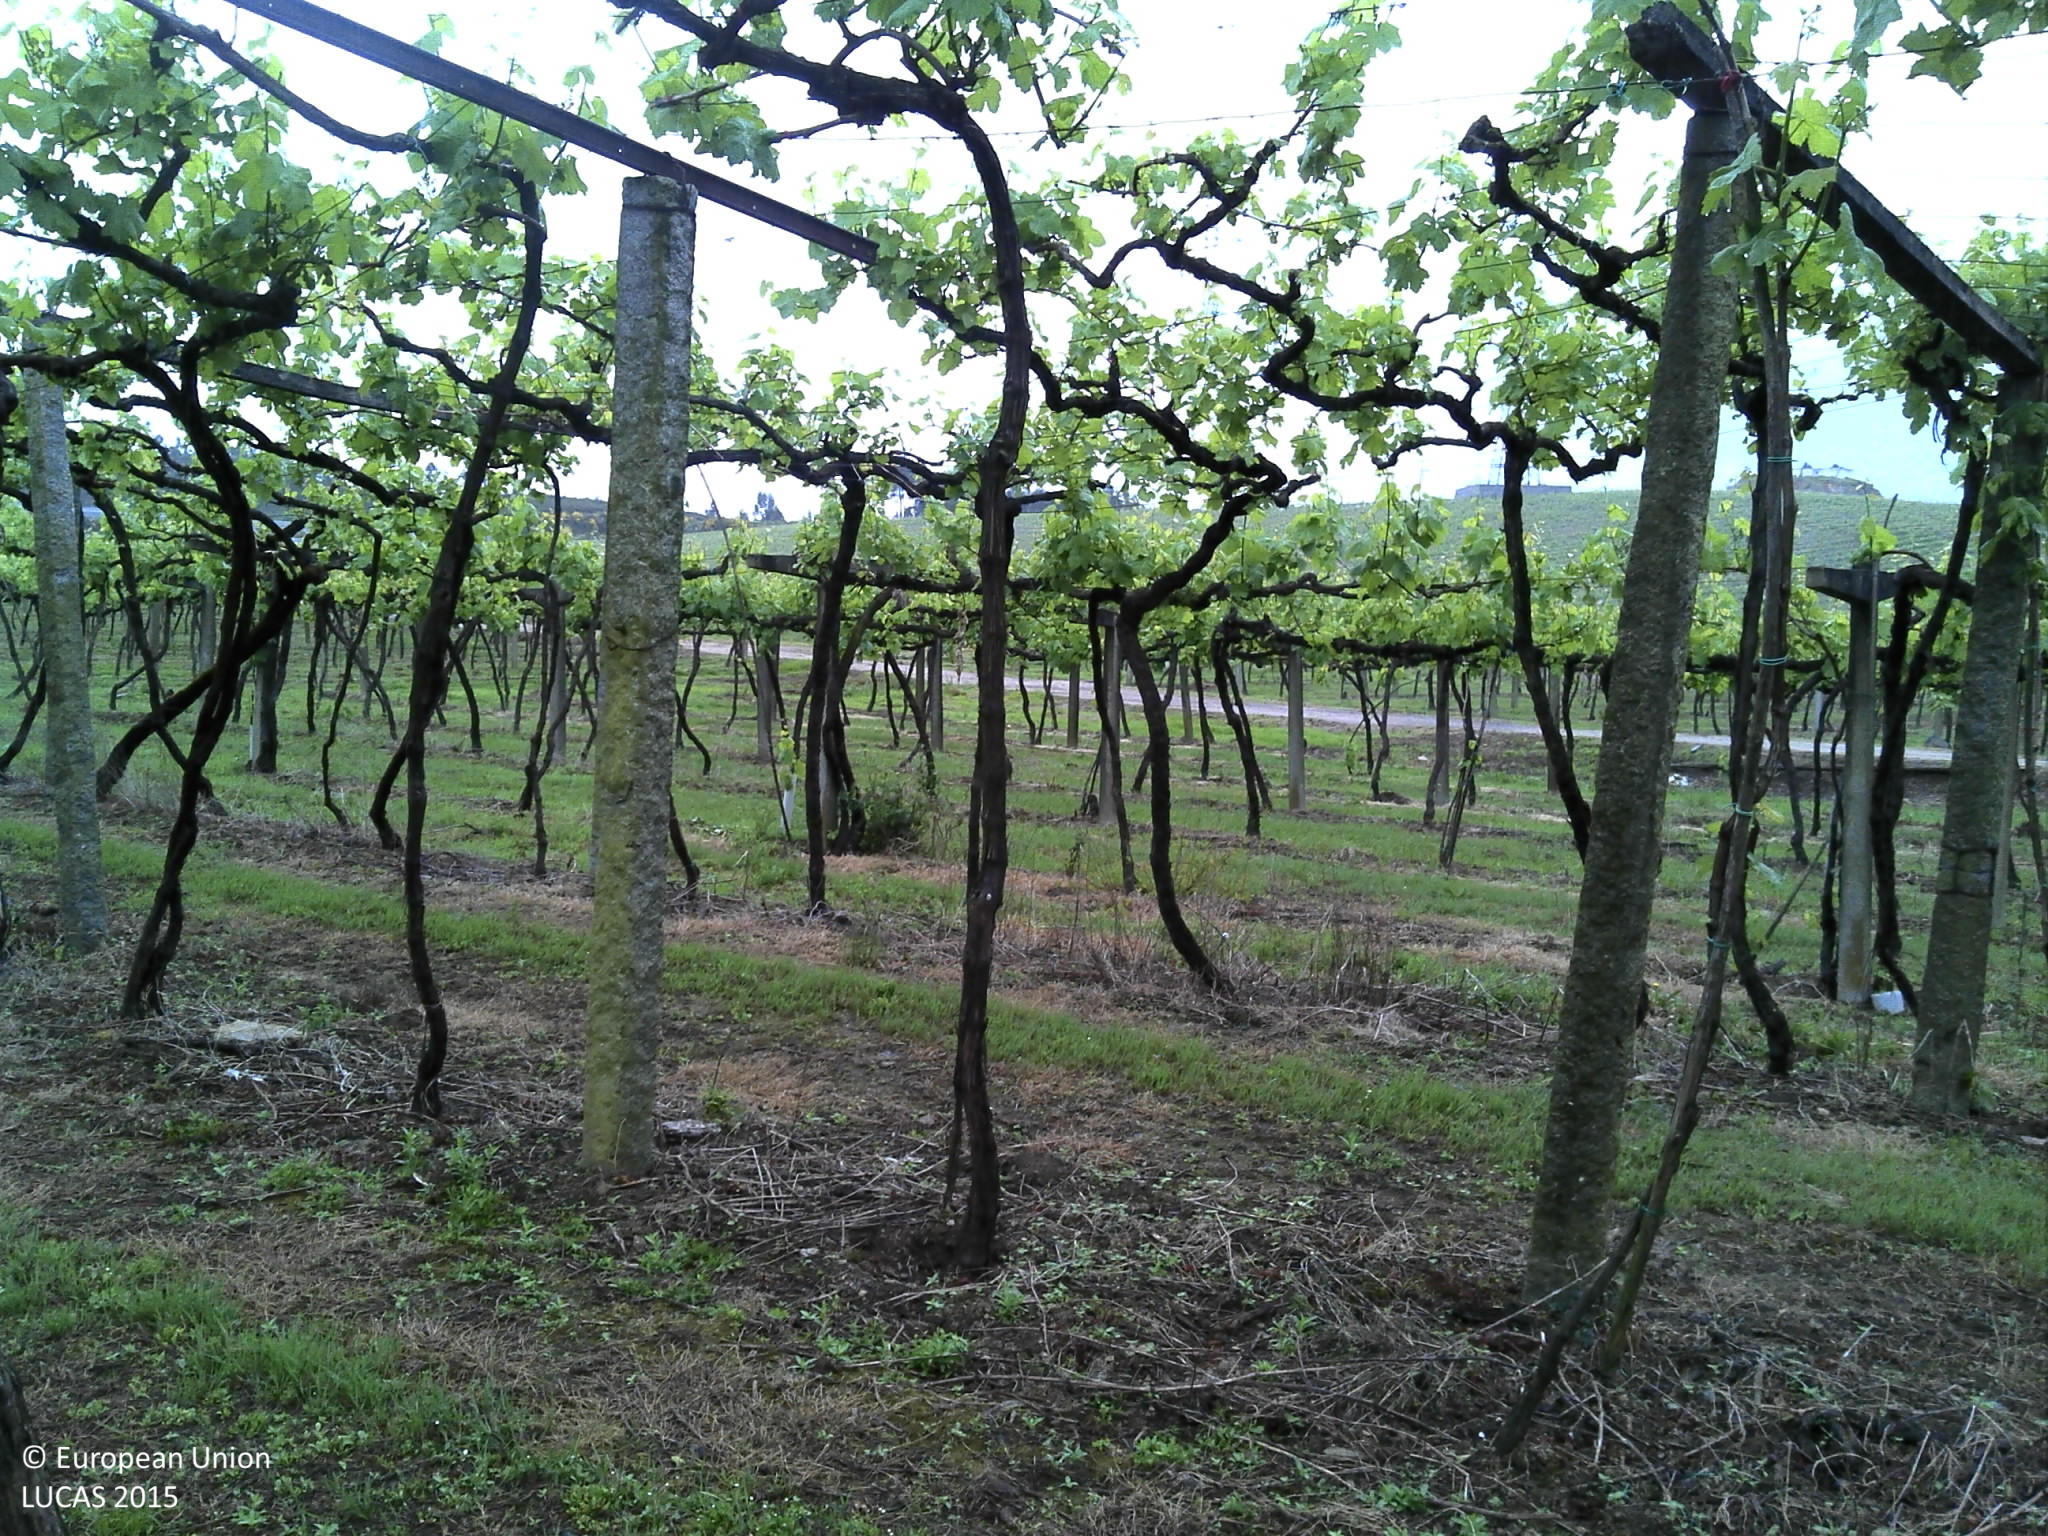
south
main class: Cropland
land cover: Vineyards
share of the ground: 50 - 75 %
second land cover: Grassland without tree/shrub cover
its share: 10 - 25 %
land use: Agriculture (excluding fallow land and kitchen gardens)
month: May
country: PT
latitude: 41.1997
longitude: -8.4530
